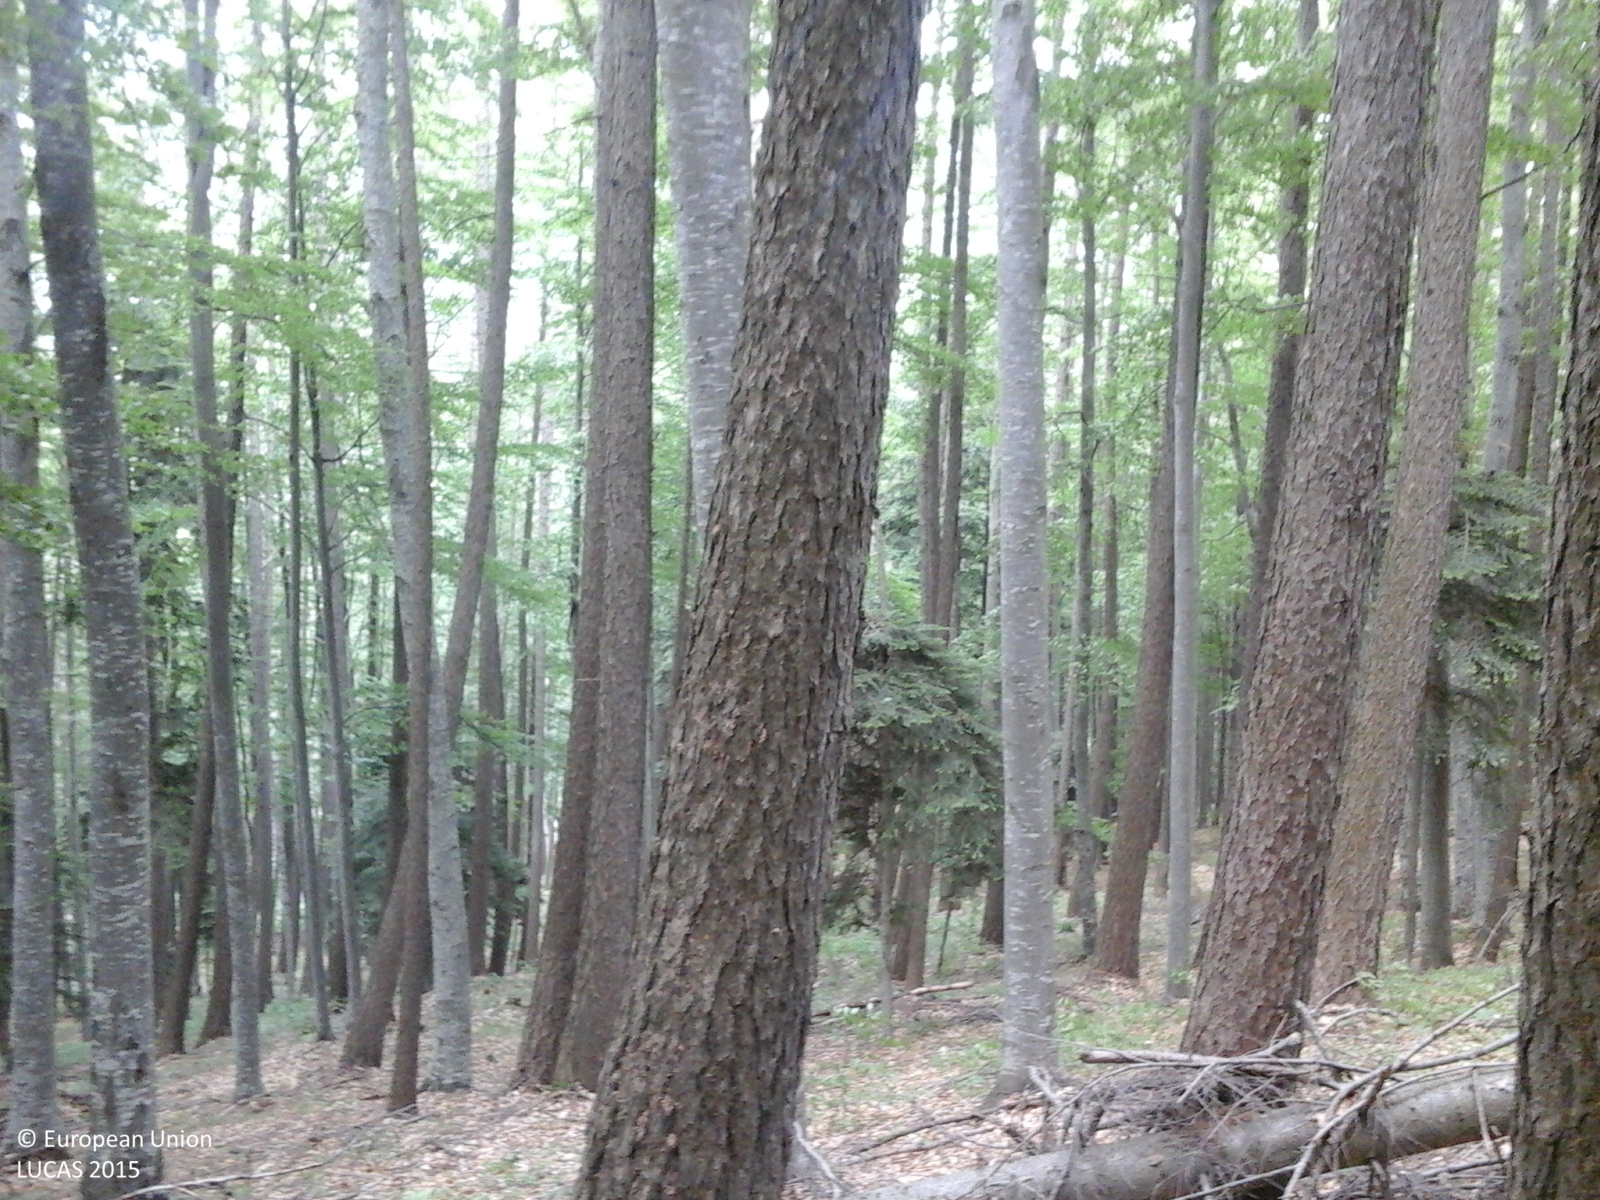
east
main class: Woodland
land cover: Other mixed woodland
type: alpine coniferous forest
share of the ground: > 75 %
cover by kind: coniferous forest trees 70 %, broadleaved forest trees 30 %
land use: Forestry
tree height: > 5 m
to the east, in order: Other mixed woodland
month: May
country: RO
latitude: 45.2553
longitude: 25.5829
